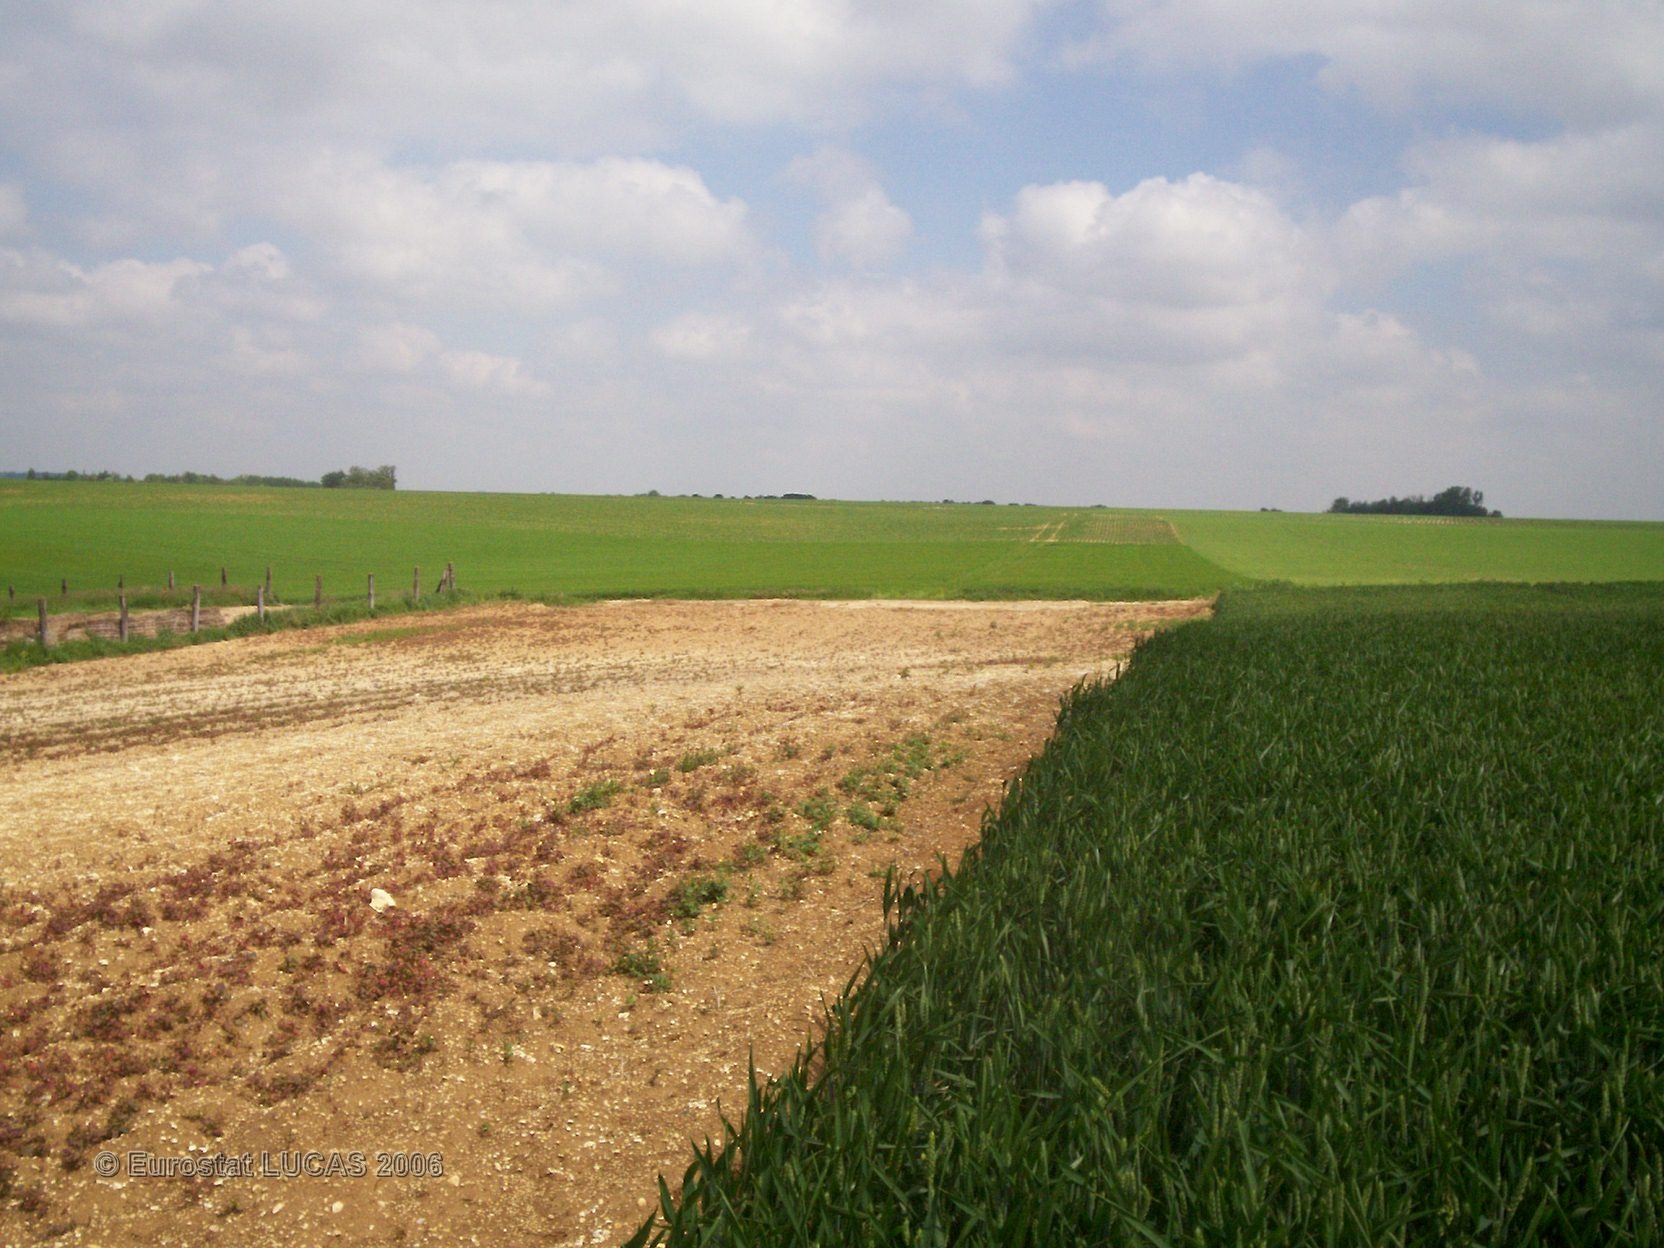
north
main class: Cropland
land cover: Common wheat
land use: Agriculture (excluding fallow land and kitchen gardens)
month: June
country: FR
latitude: 49.8965
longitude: 2.7080
